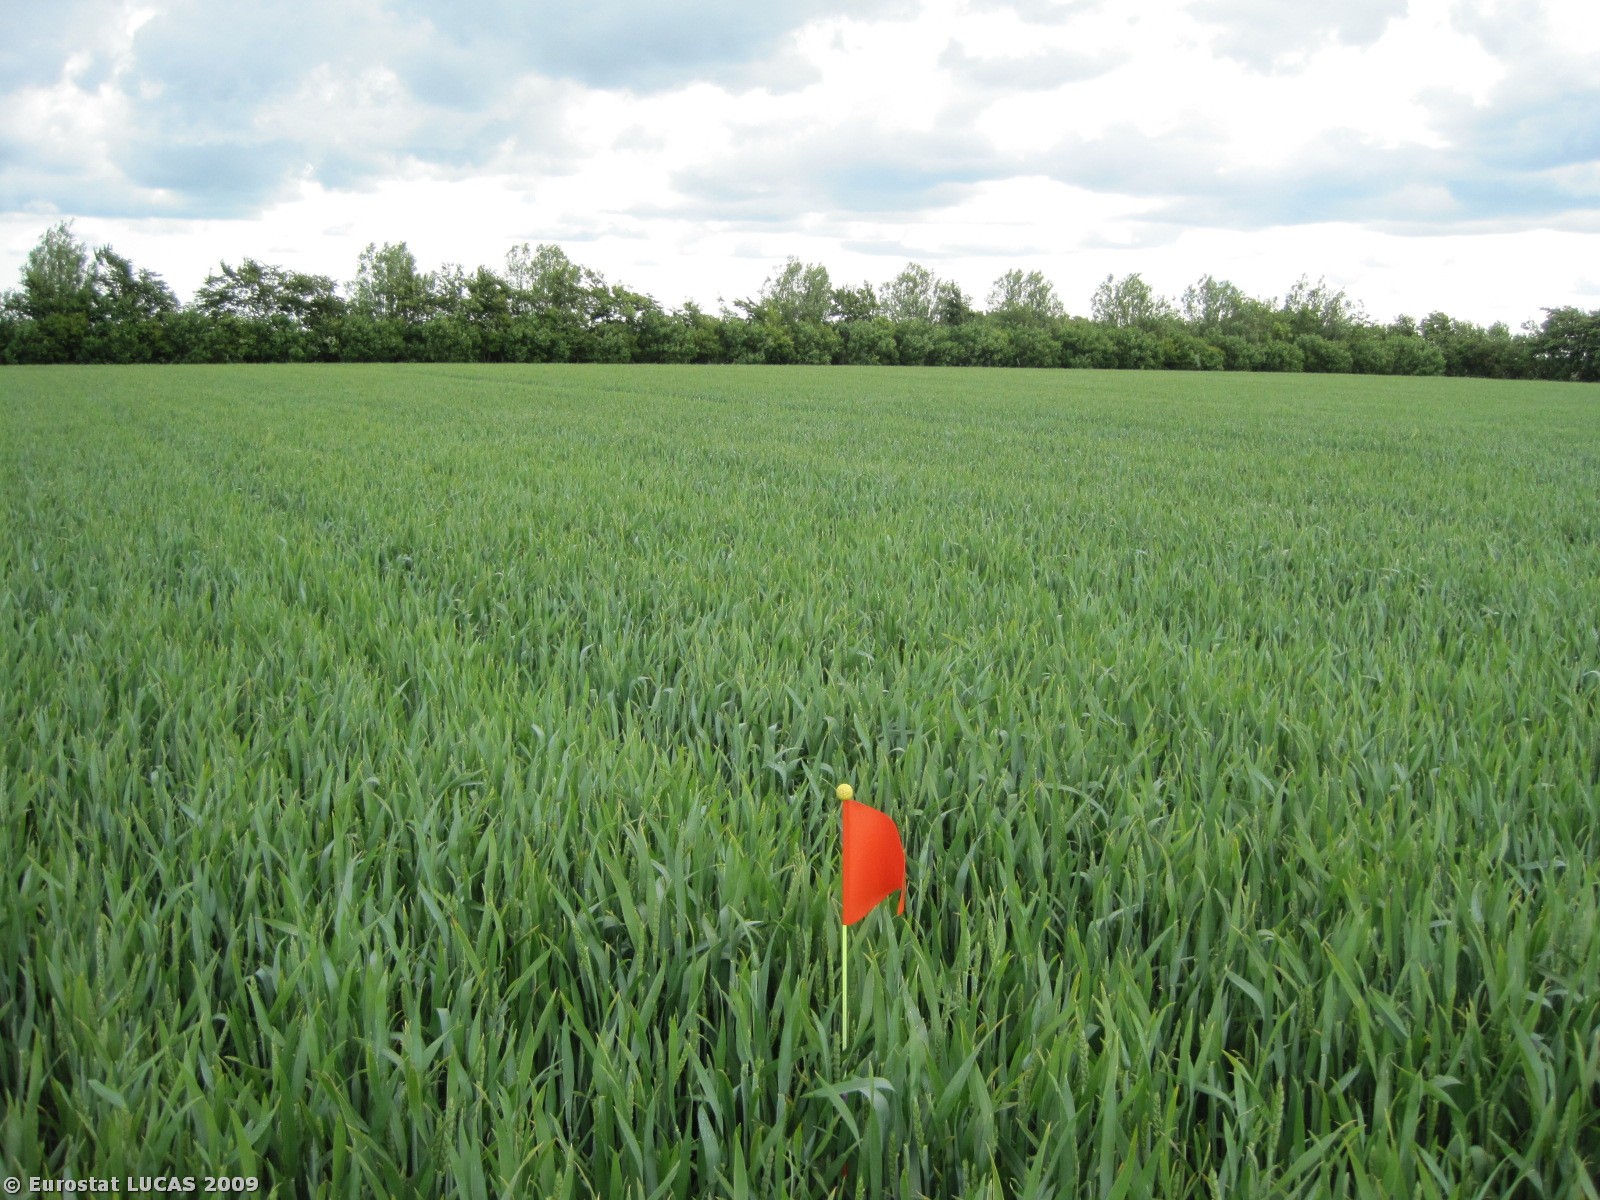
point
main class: Cropland
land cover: Common wheat
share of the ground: > 75 %
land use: Agriculture (excluding fallow land and kitchen gardens)
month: June
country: DK
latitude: 57.2662
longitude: 9.7848
